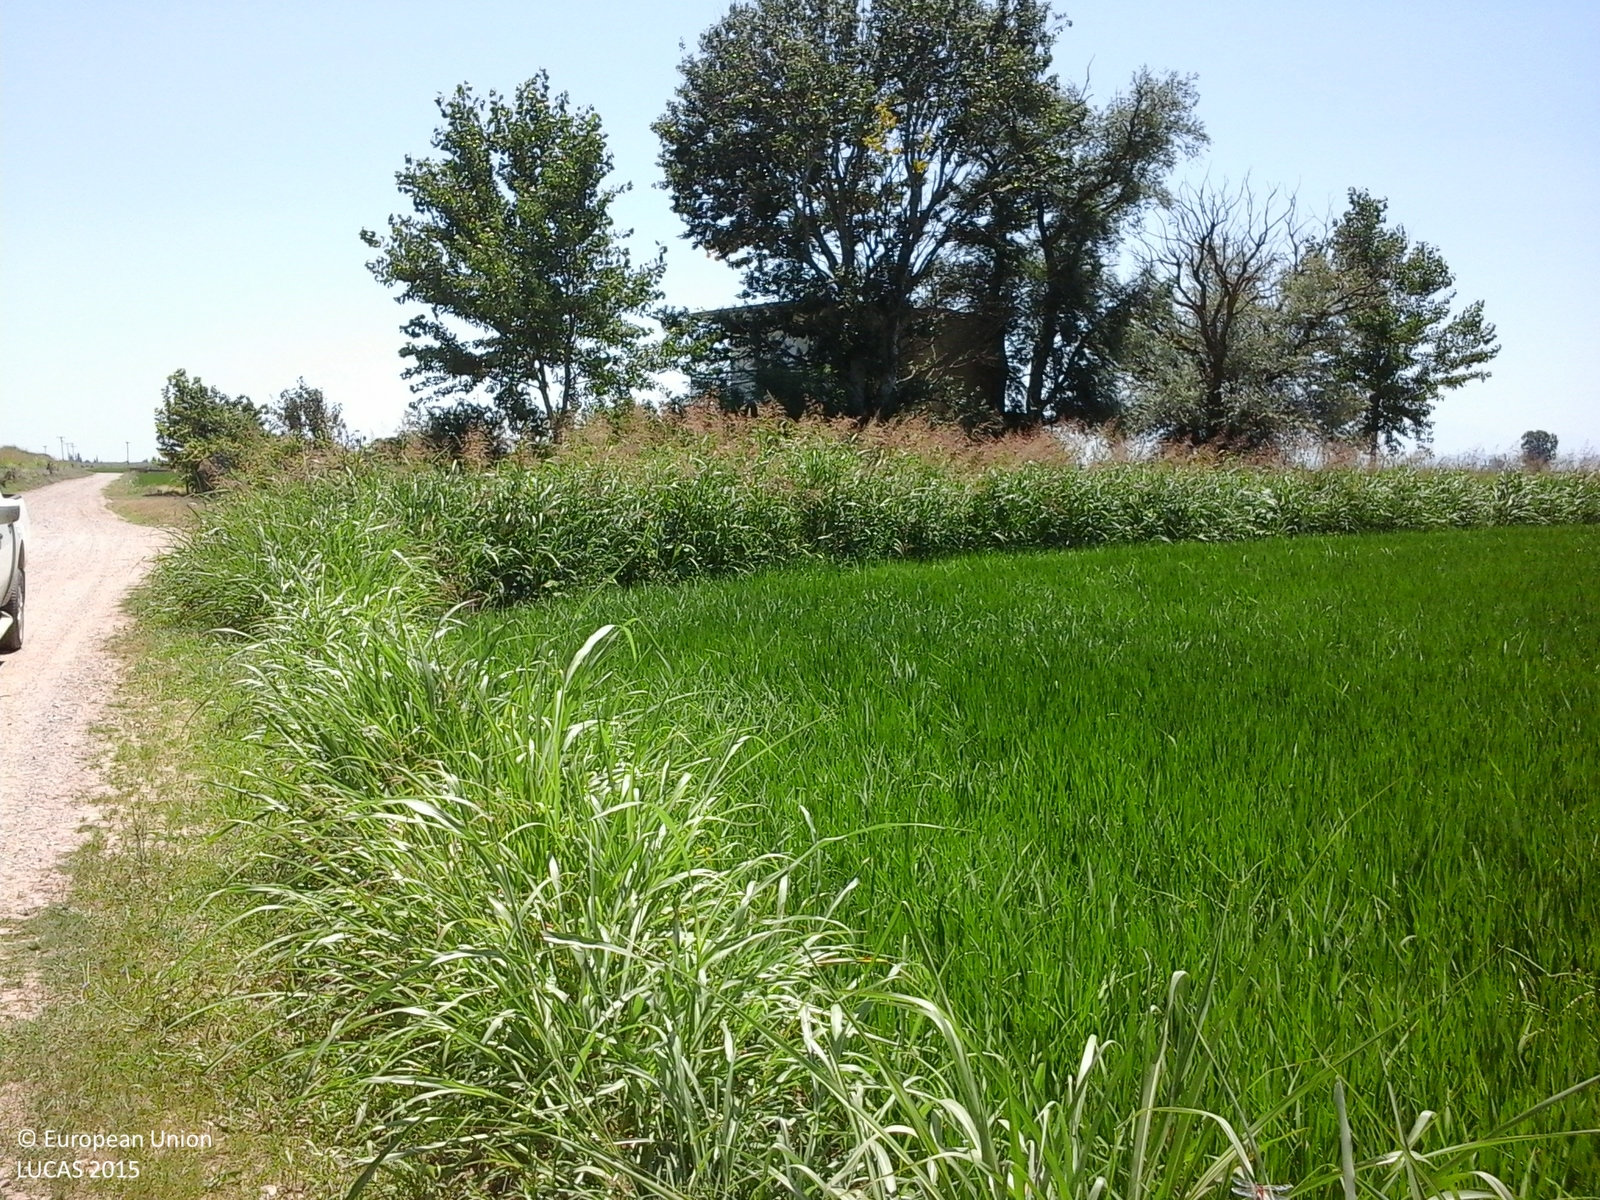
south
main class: Cropland
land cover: Rice
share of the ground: > 75 %
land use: Agriculture (excluding fallow land and kitchen gardens)
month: July
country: GR
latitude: 40.6135
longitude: 22.6627
